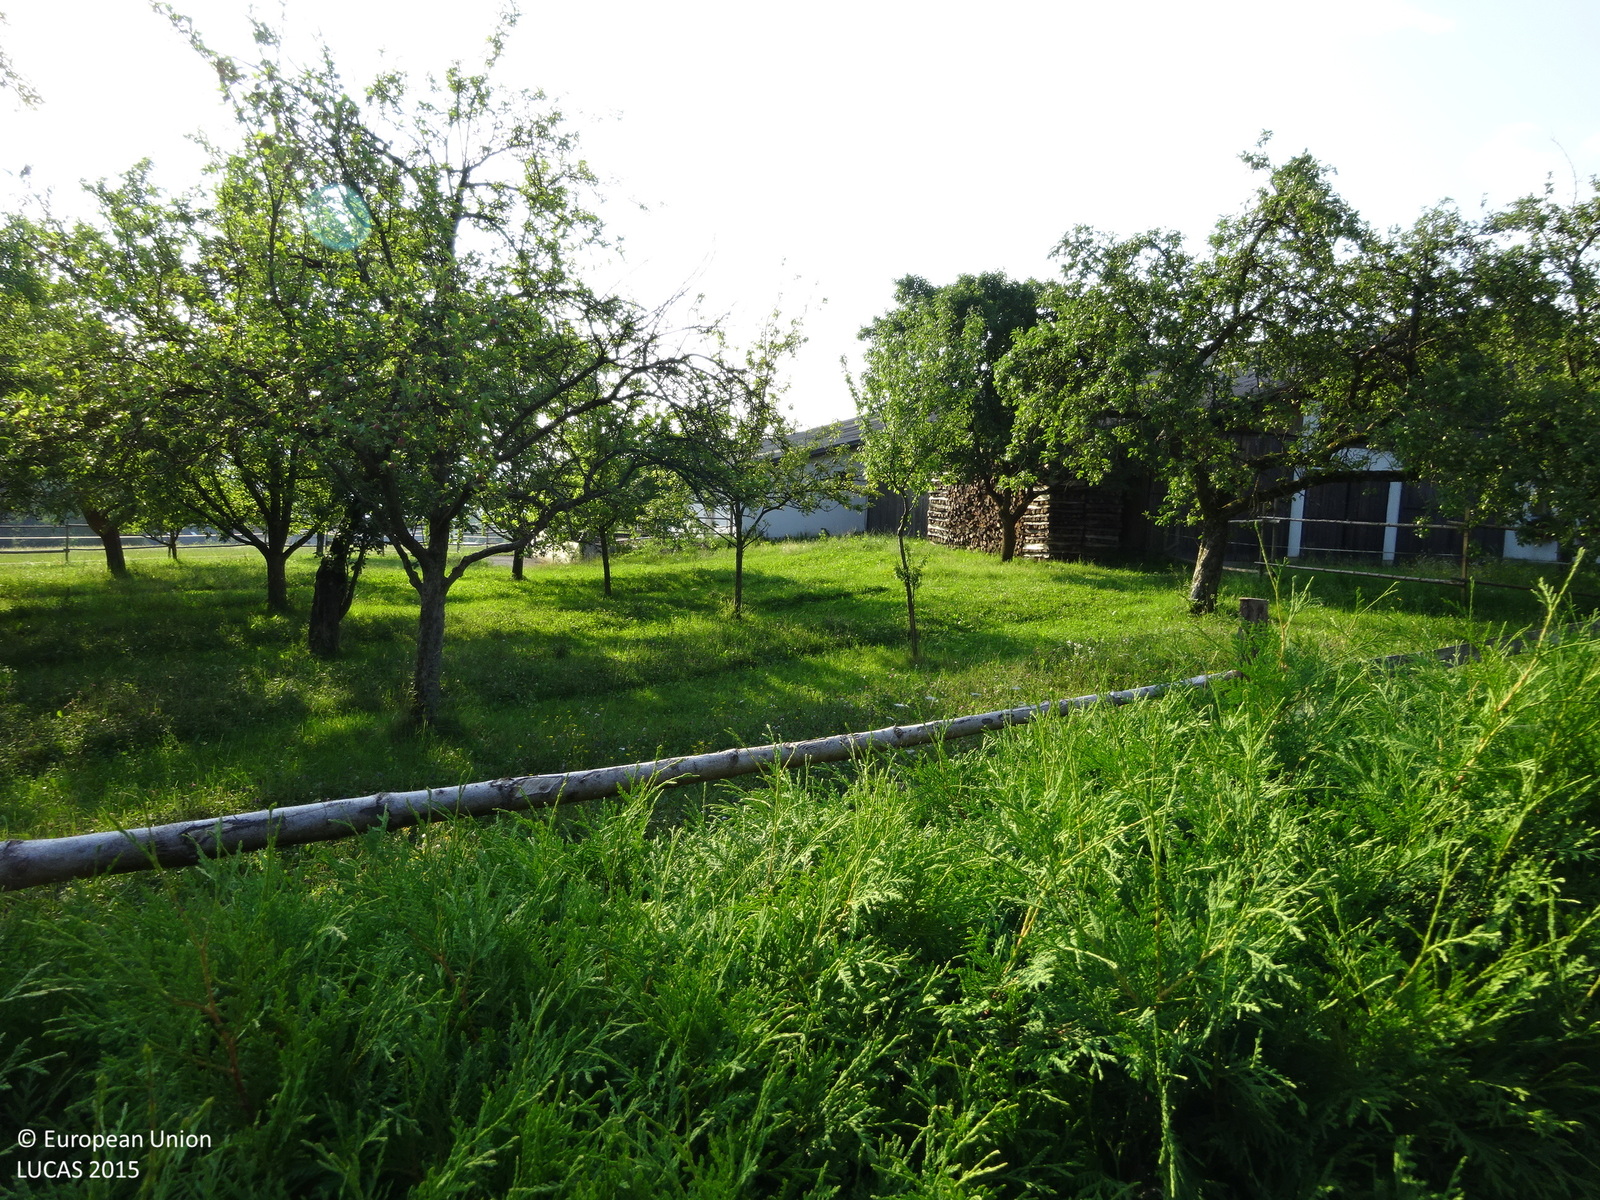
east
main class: Cropland
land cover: Apple fruit
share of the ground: > 75 %
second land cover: Grassland without tree/shrub cover
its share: > 75 %
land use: Agriculture (excluding fallow land and kitchen gardens)
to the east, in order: Apple fruit; Grassland without tree/shrub cover; Fences; Grassland without tree/shrub cover; Grassland with sparse tree/shrub cover; Artificial constructions in urban areas; Grassland without tree/shrub cover
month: July
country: AT
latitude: 47.1408
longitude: 15.2872
